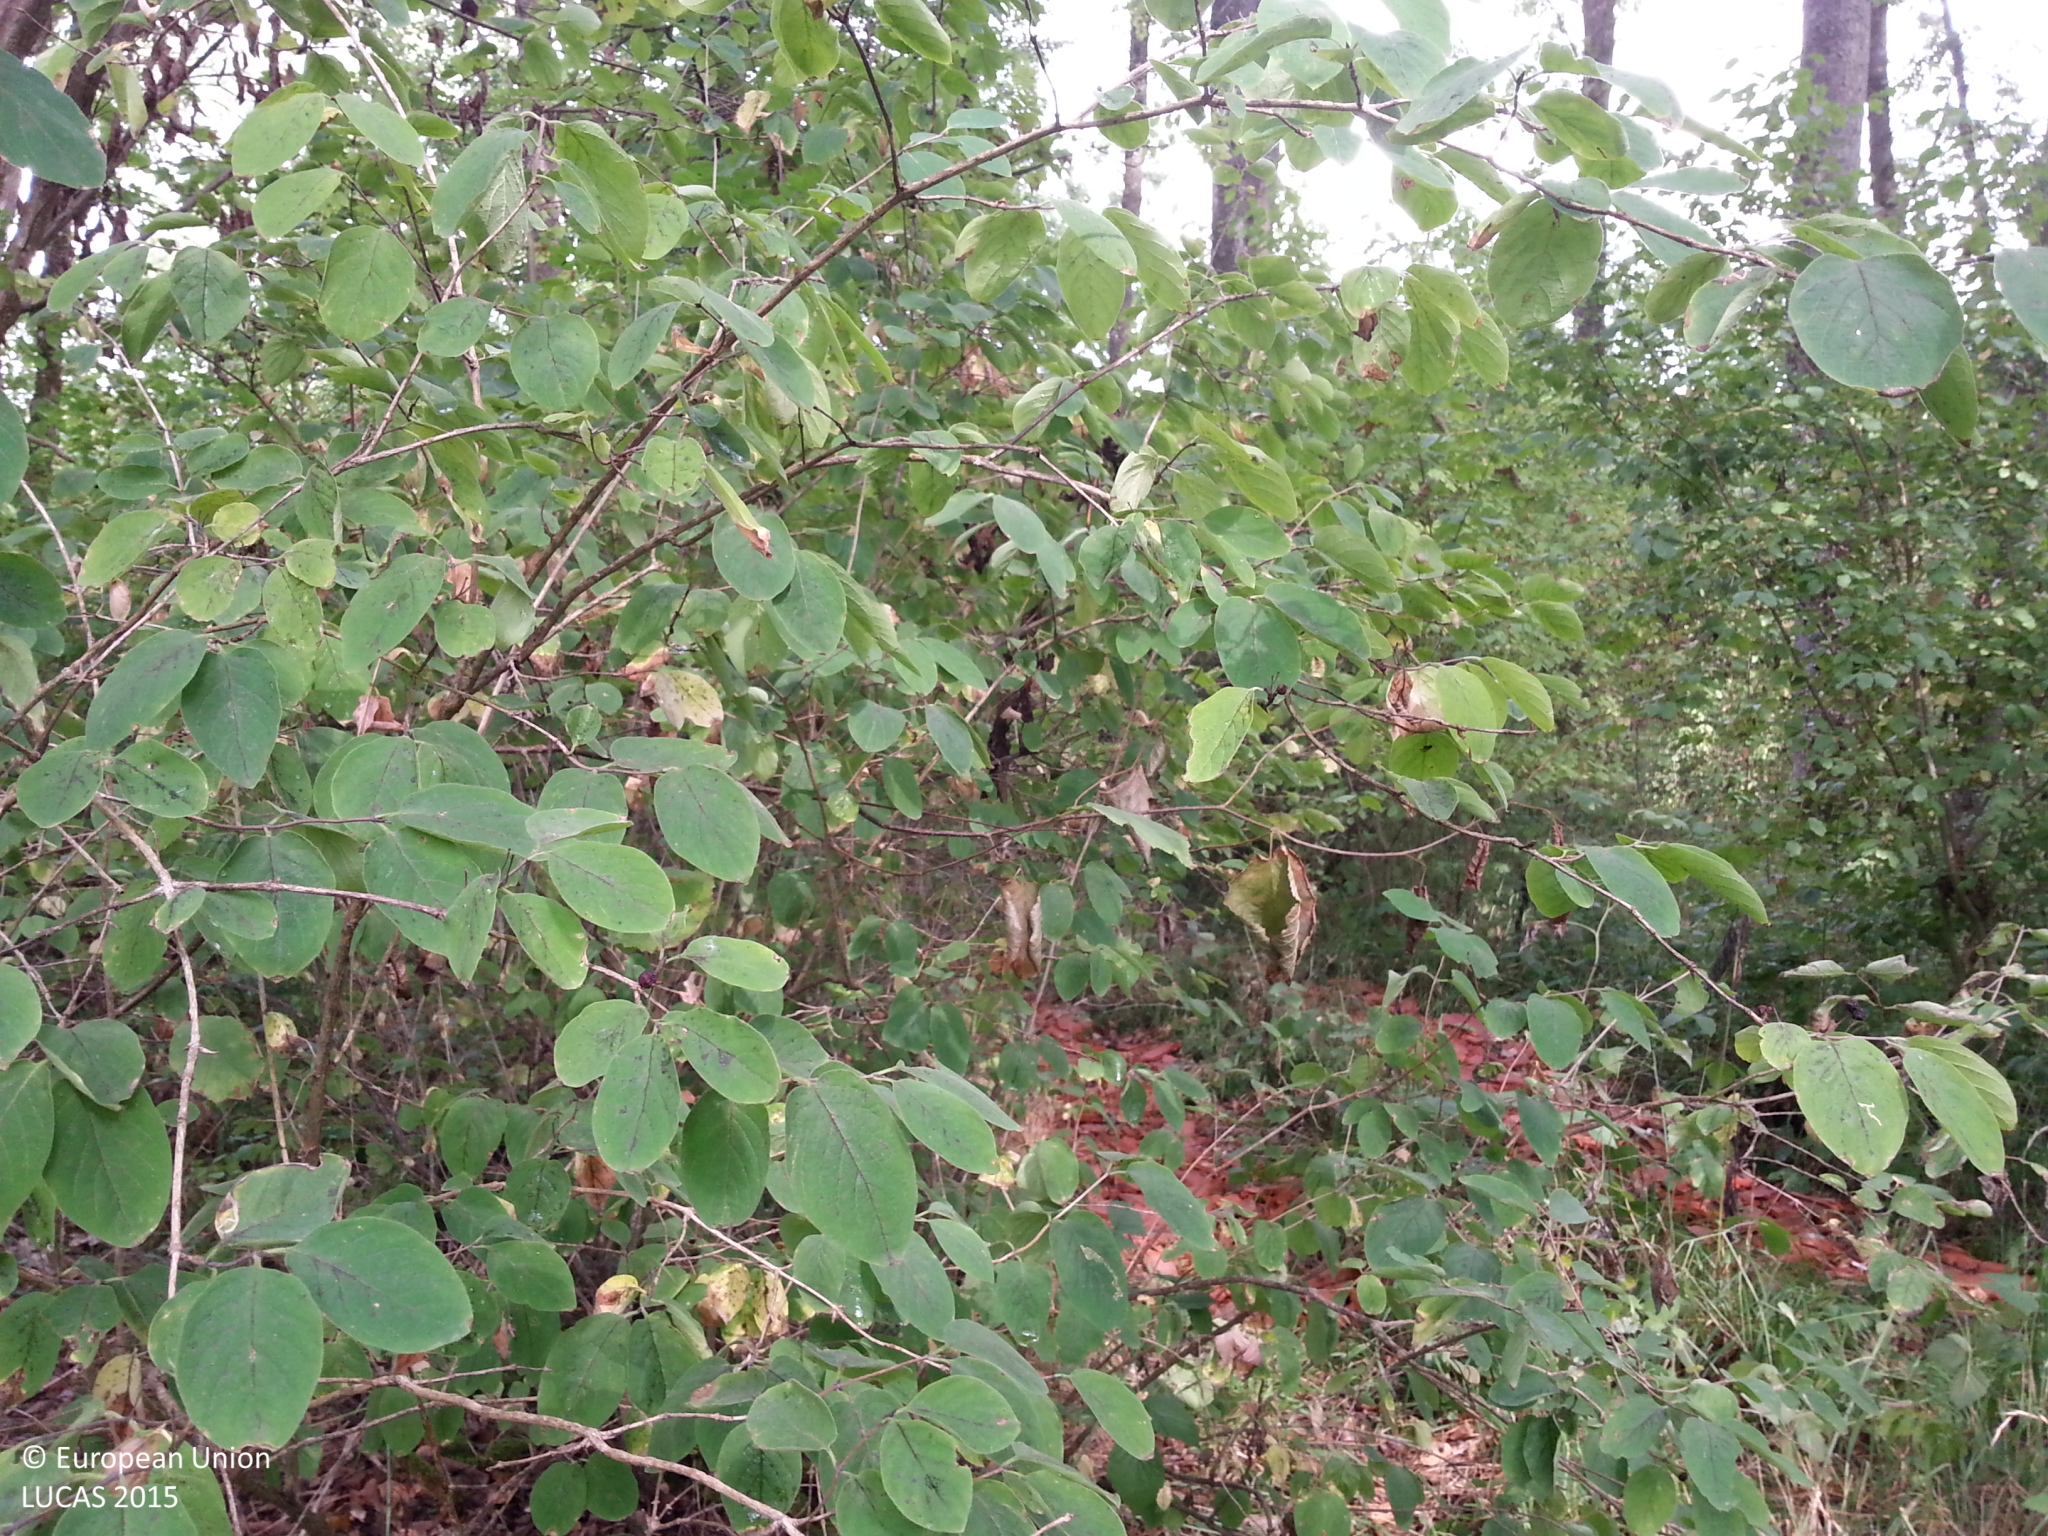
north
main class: Woodland
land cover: Broadleaved woodland
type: acidophilous oak and oak-birch forest
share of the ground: 50 - 75 %
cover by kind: broadleaved forest trees 70 %, shrubs 15 %, herbaceous plants 15 %
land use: Forestry
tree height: > 5 m
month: September
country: DE
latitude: 49.2850
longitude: 9.9038
